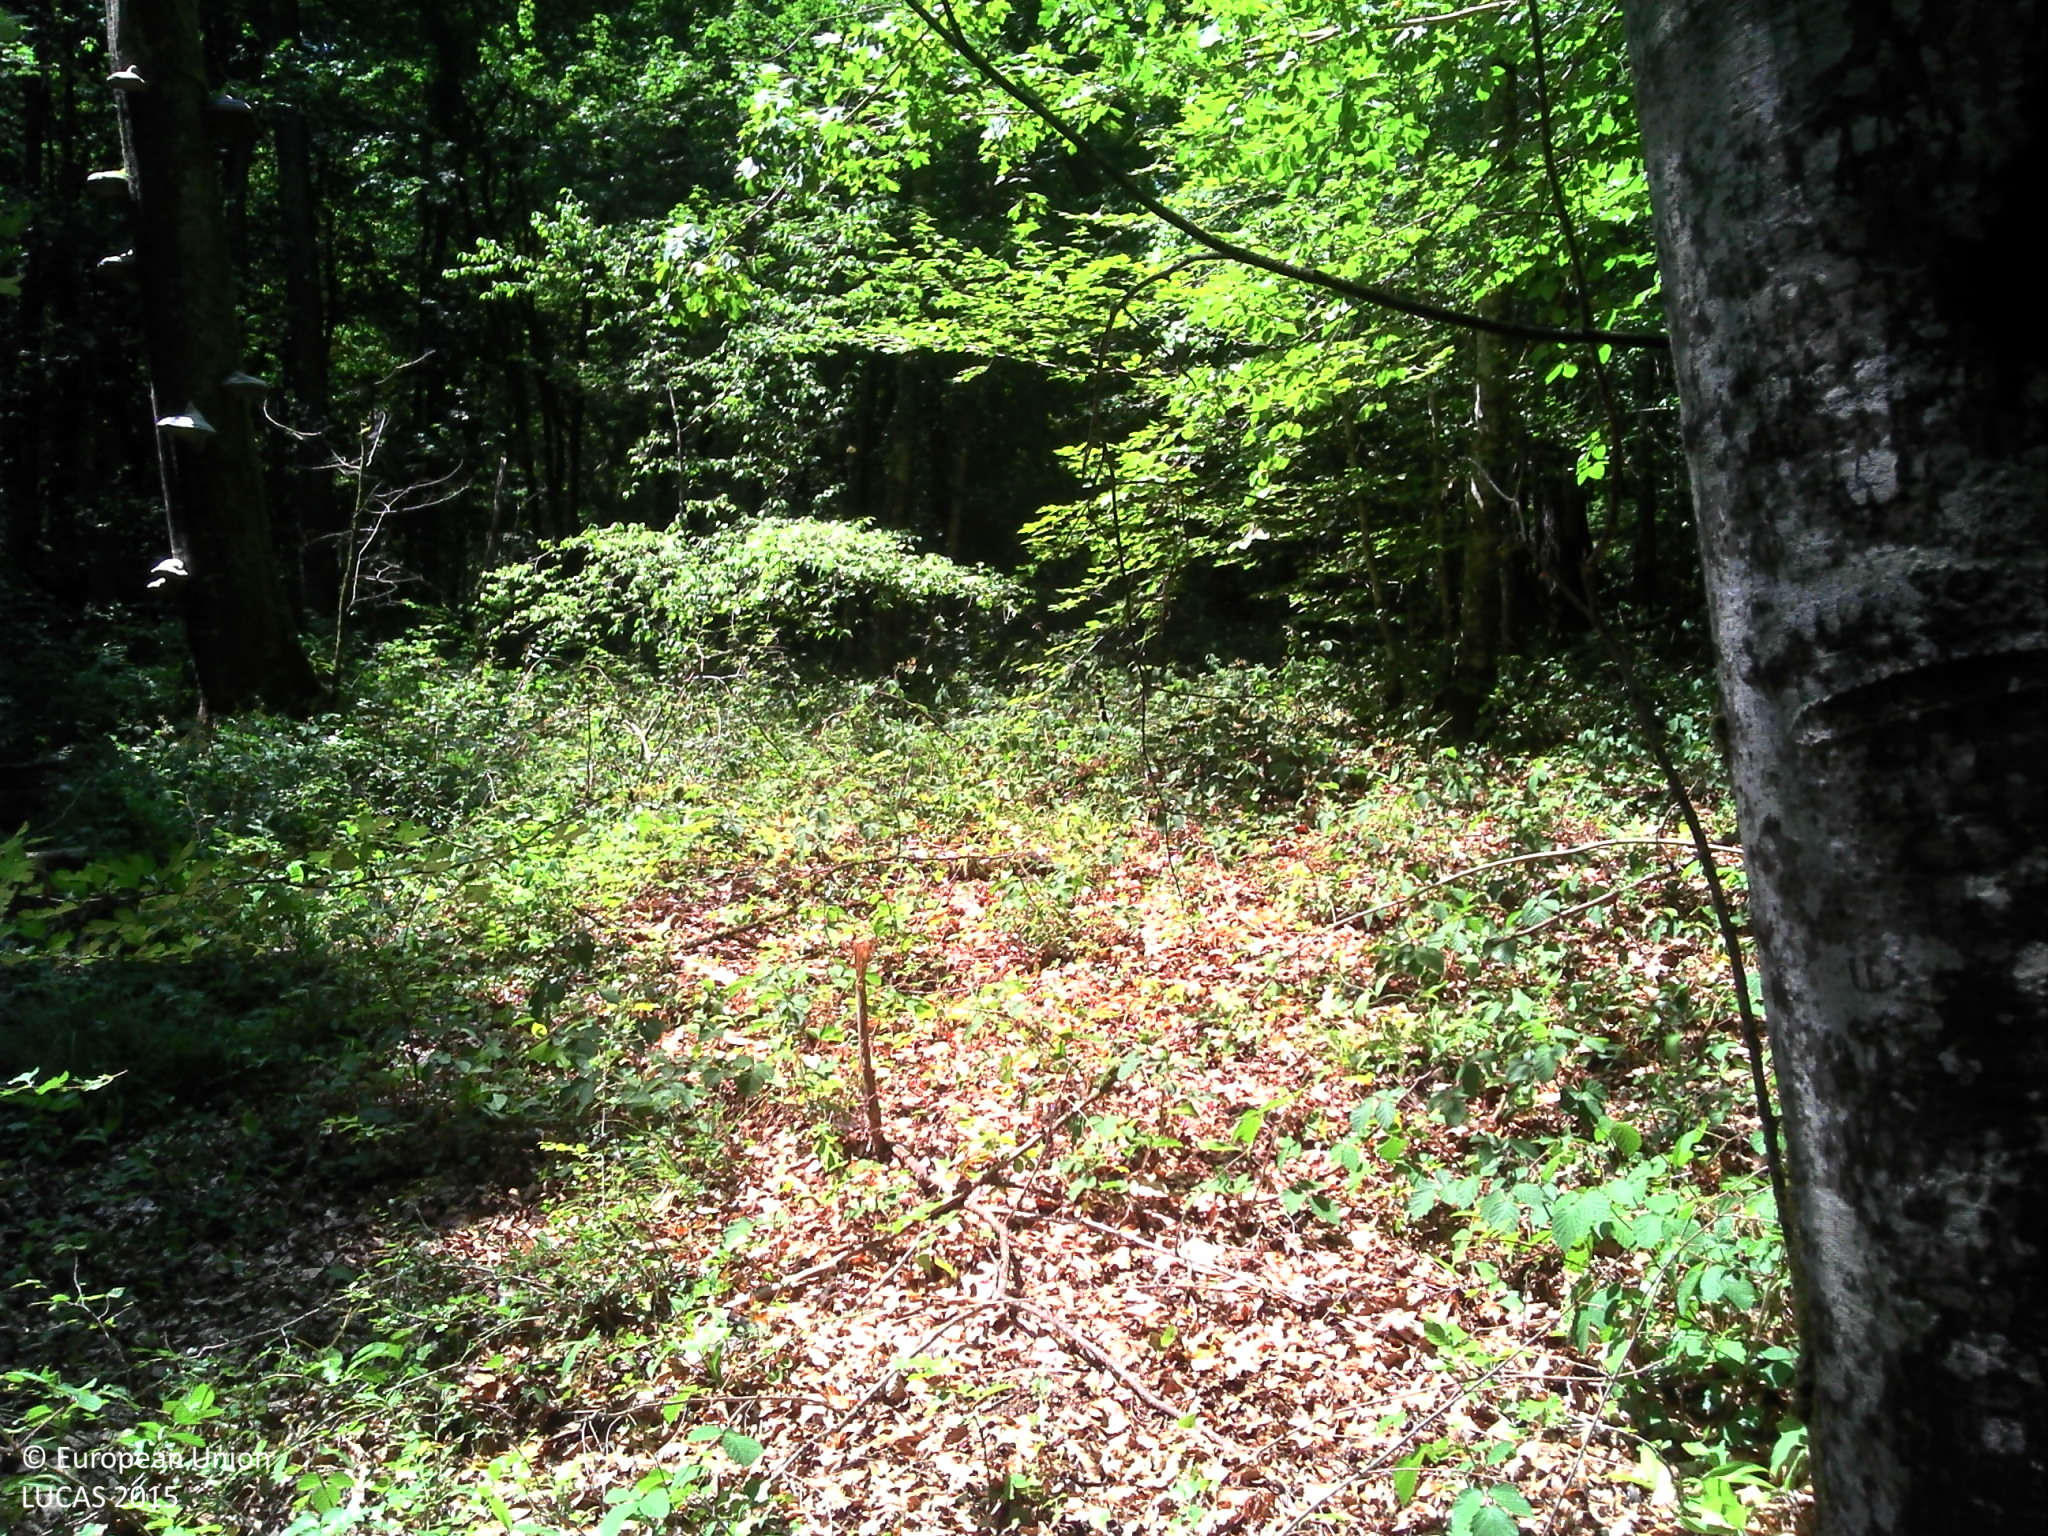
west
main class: Woodland
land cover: Broadleaved woodland
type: beech forest
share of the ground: > 75 %
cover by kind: broadleaved forest trees 85 %, lichens and mosses 10 %, herbaceous plants 5 %
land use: Forestry
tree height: > 5 m
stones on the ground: < 10 %
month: July
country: FR
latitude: 48.1214
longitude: 4.8534
